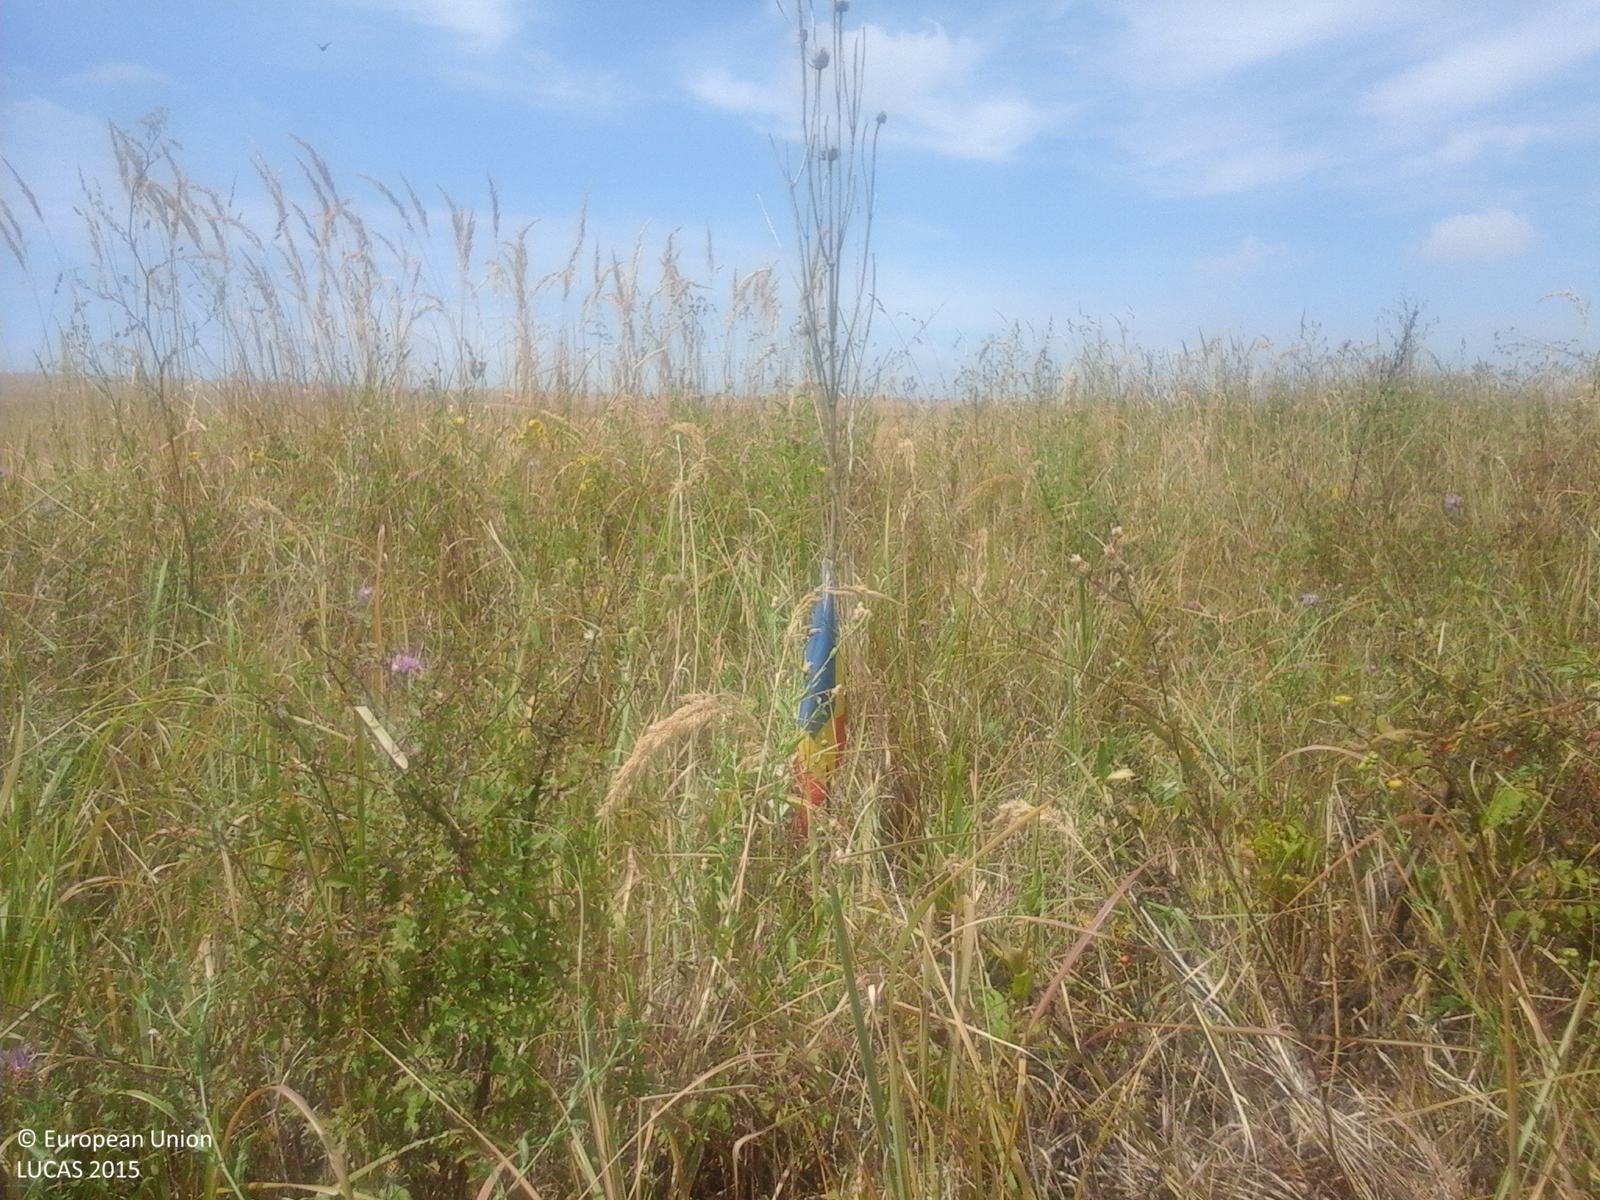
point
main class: Grassland
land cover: Spontaneously vegetated surfaces
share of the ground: > 75 %
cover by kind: herbaceous plants 100 %
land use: Fallow land
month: August
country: RO
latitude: 44.9205
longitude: 21.5704
